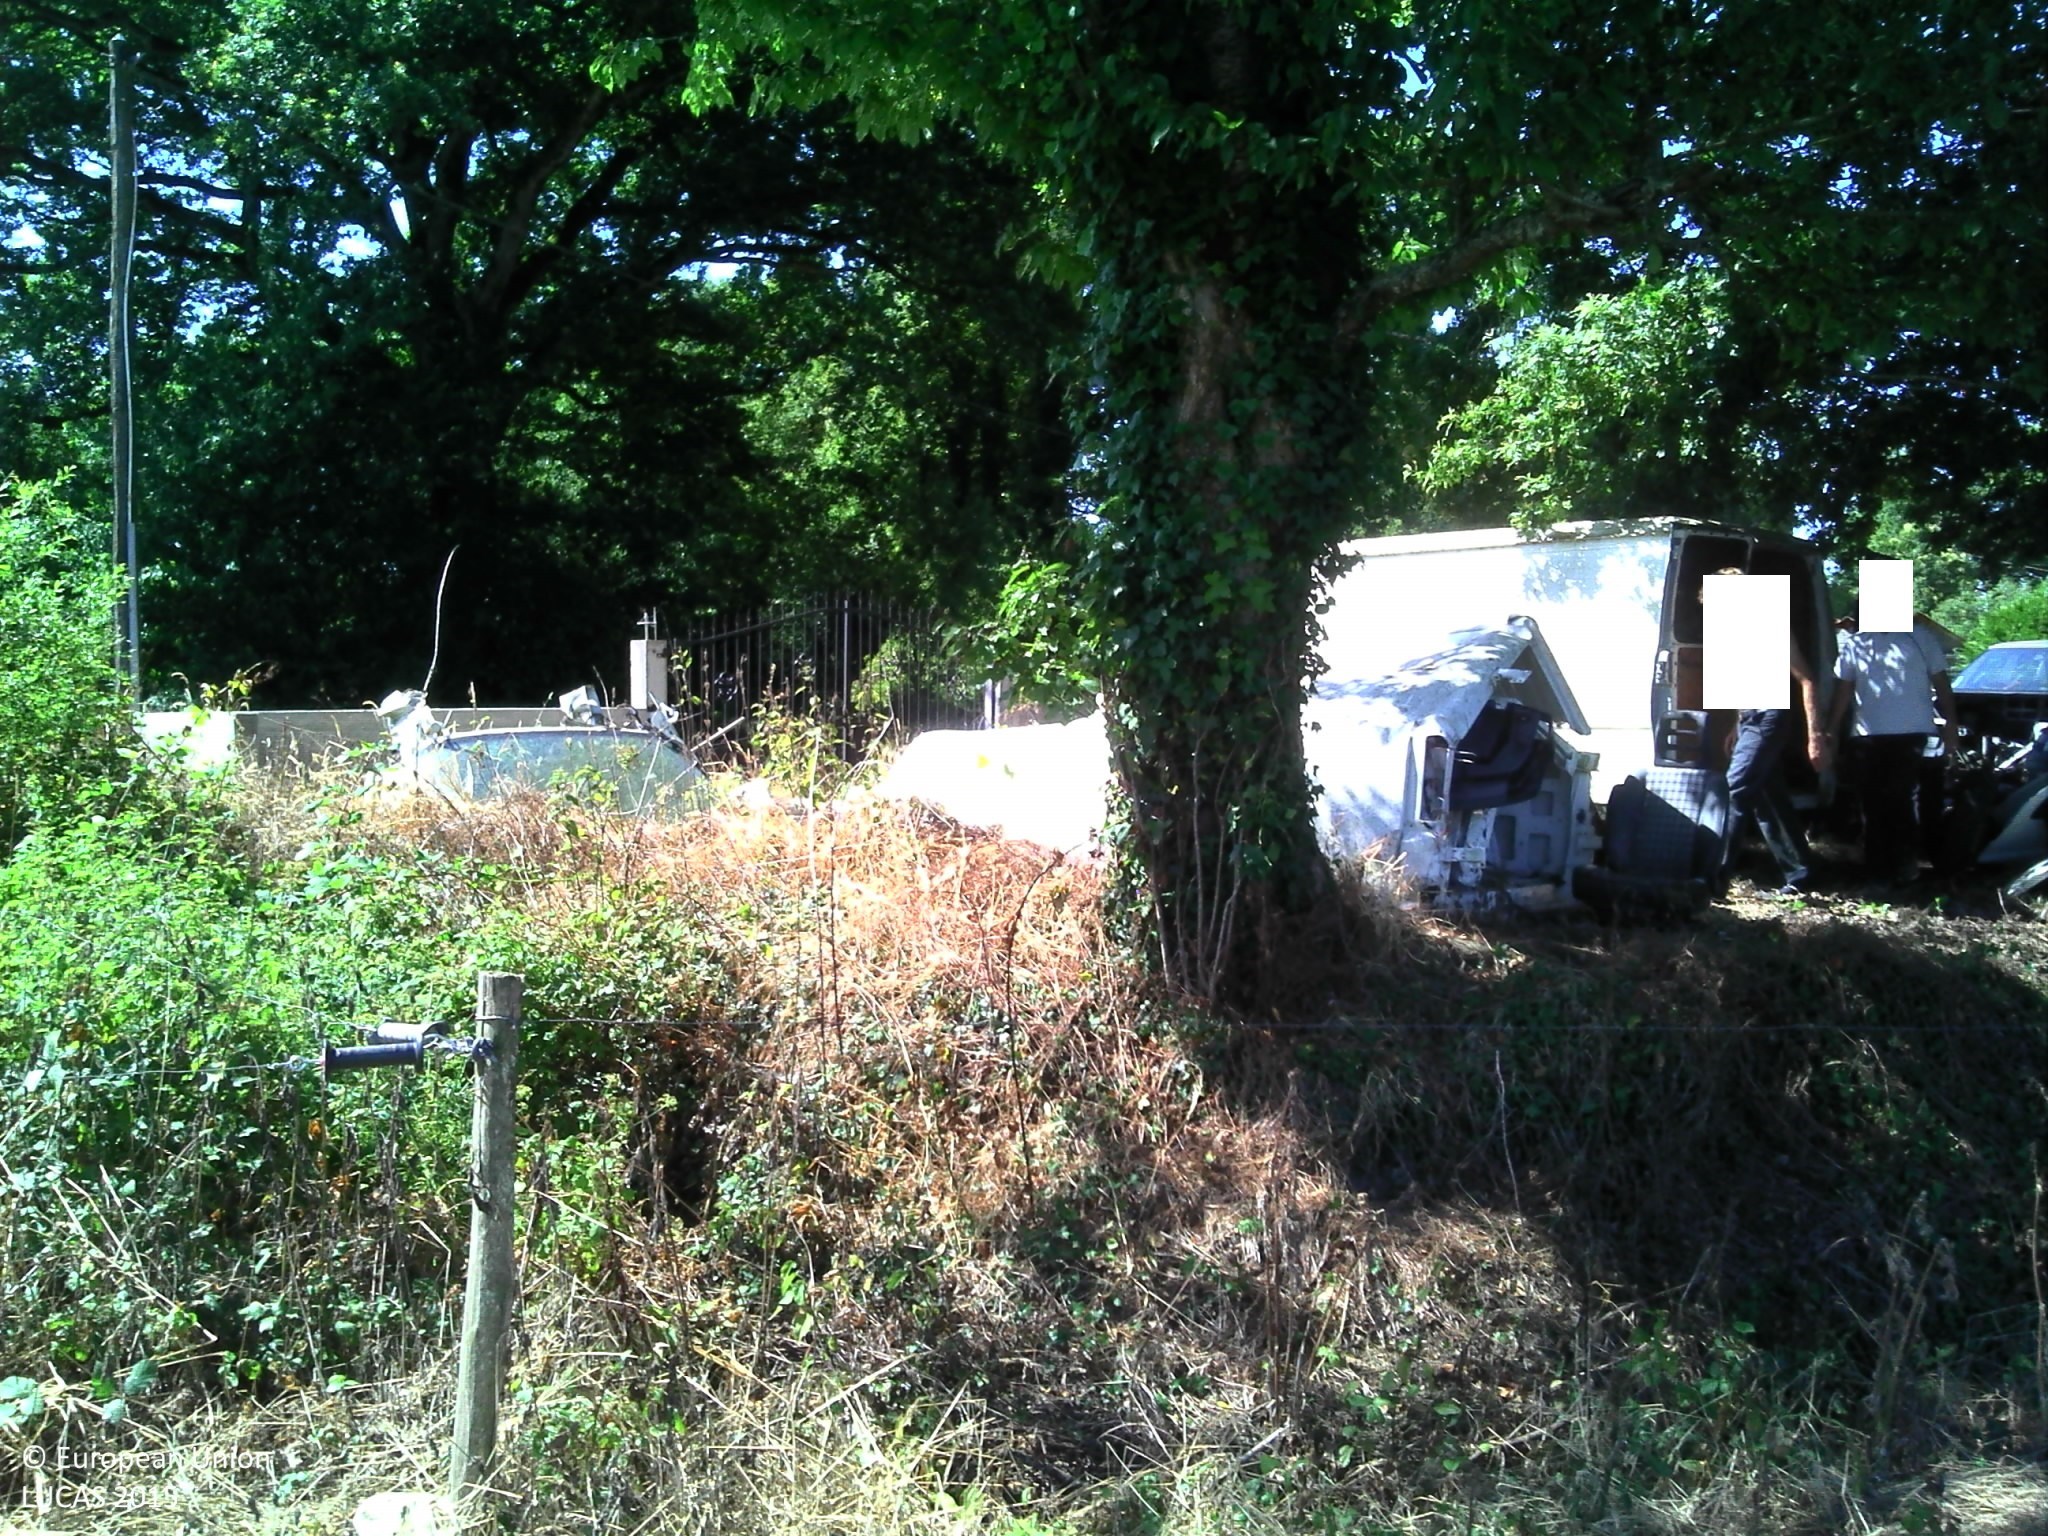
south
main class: Cropland
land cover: Maize
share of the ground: 25 - 50 %
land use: Agriculture (excluding fallow land and kitchen gardens)
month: June
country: FR
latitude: 46.9263
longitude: -1.6915
